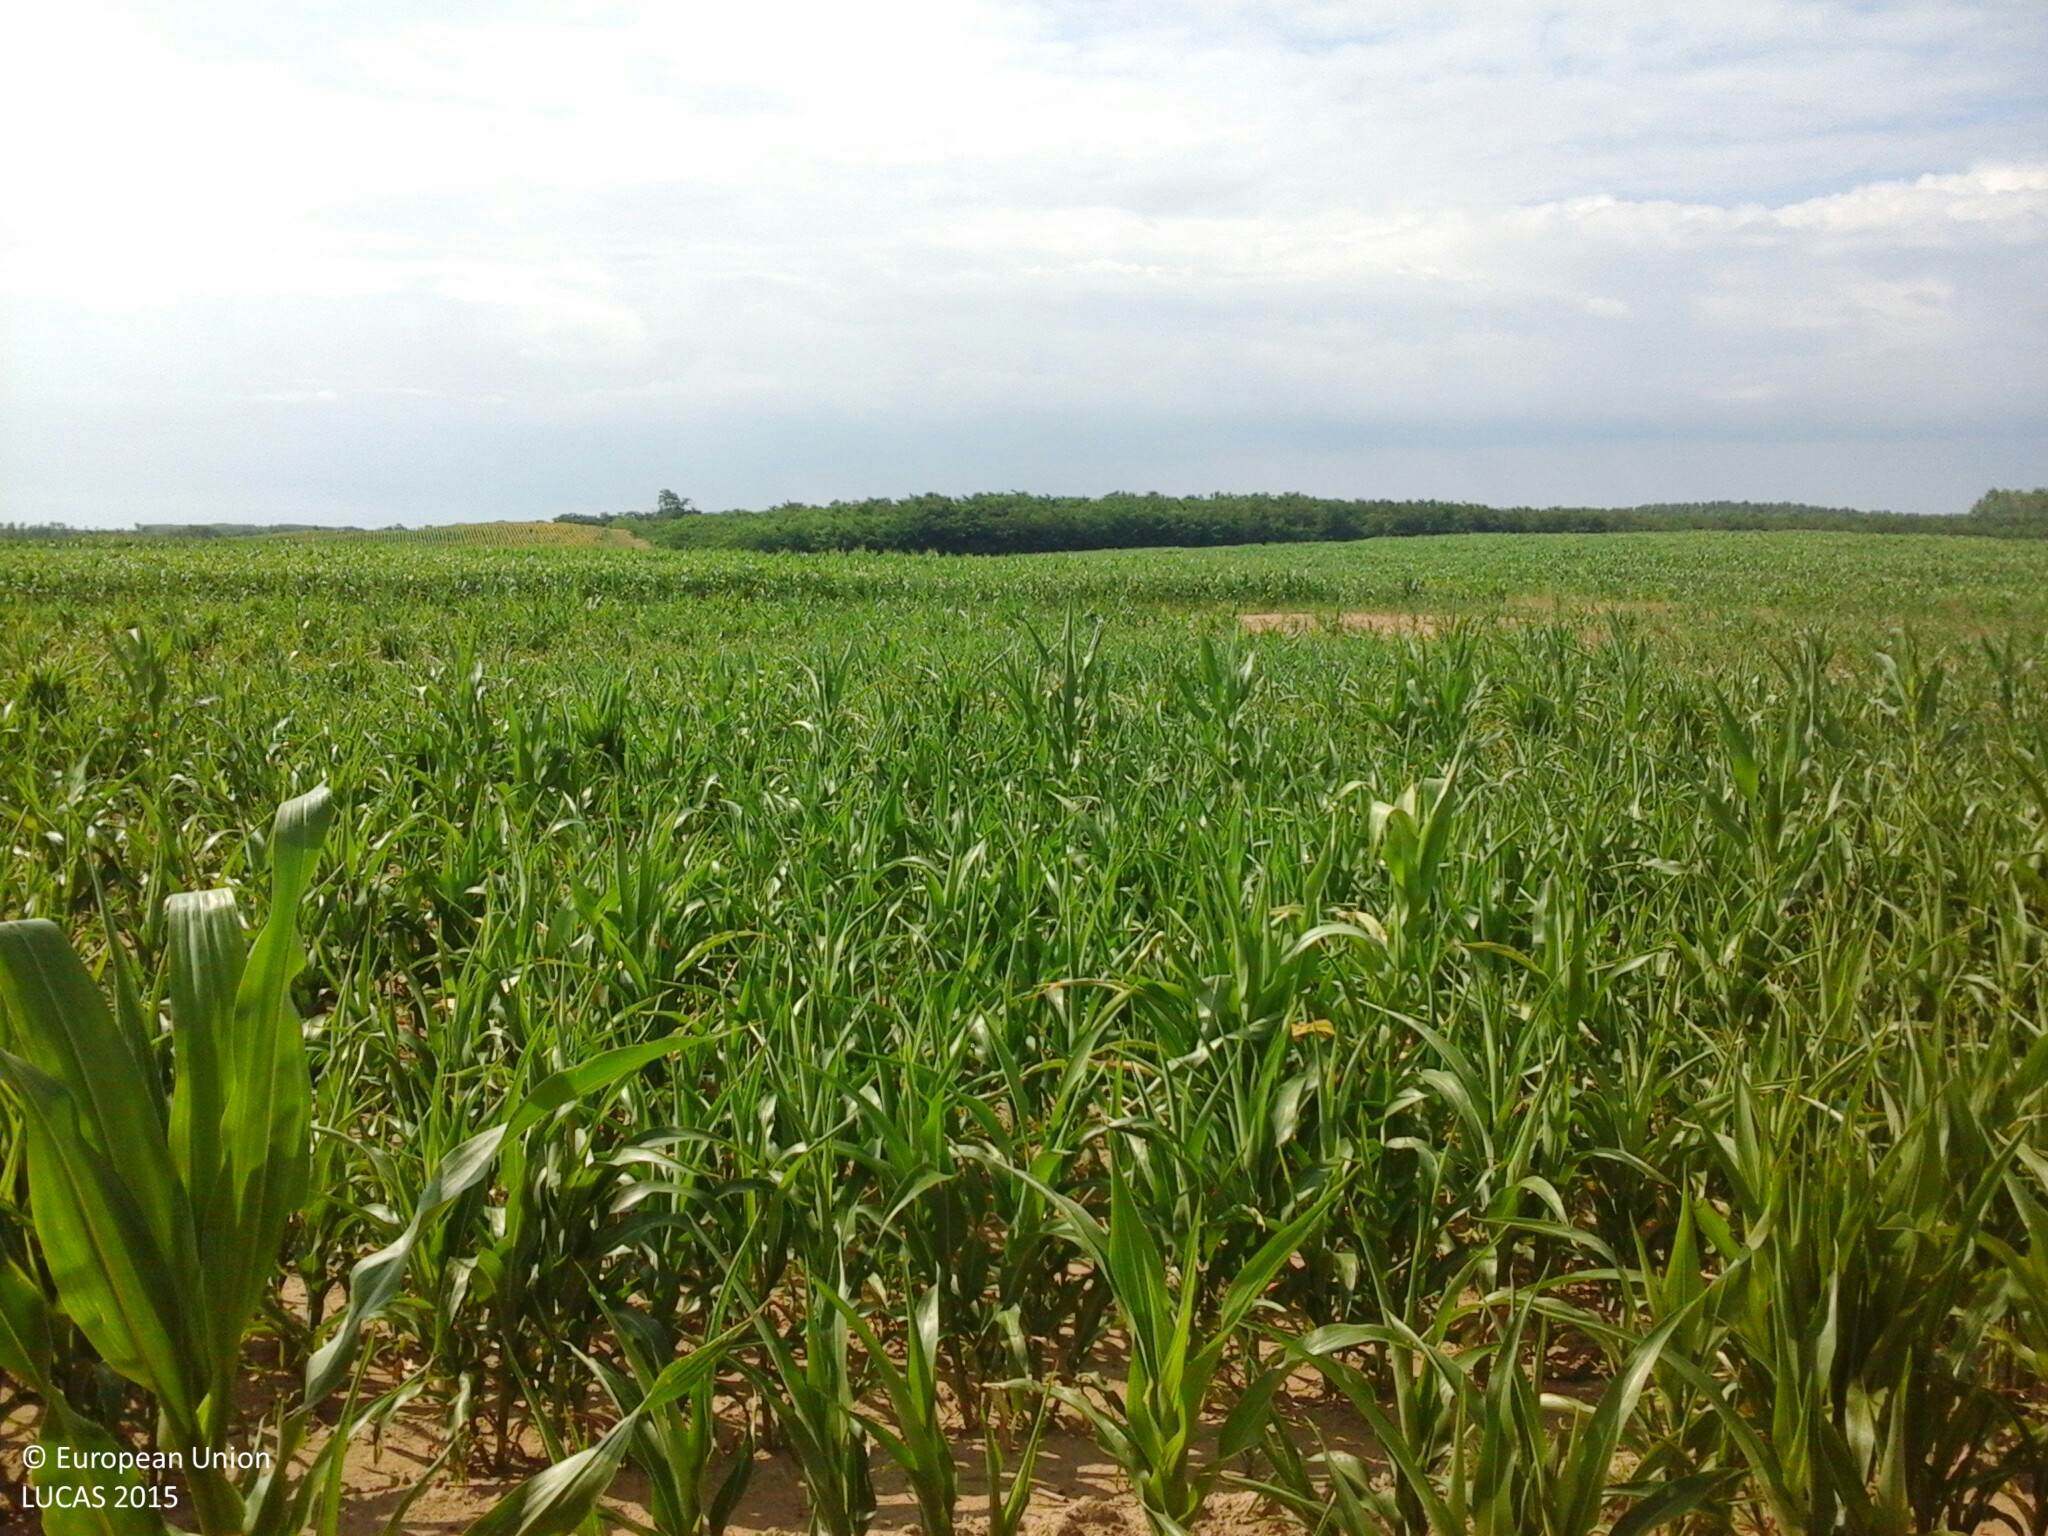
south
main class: Cropland
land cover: Maize
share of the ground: 50 - 75 %
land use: Agriculture (excluding fallow land and kitchen gardens)
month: July
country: HU
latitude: 48.3983
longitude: 22.1992
